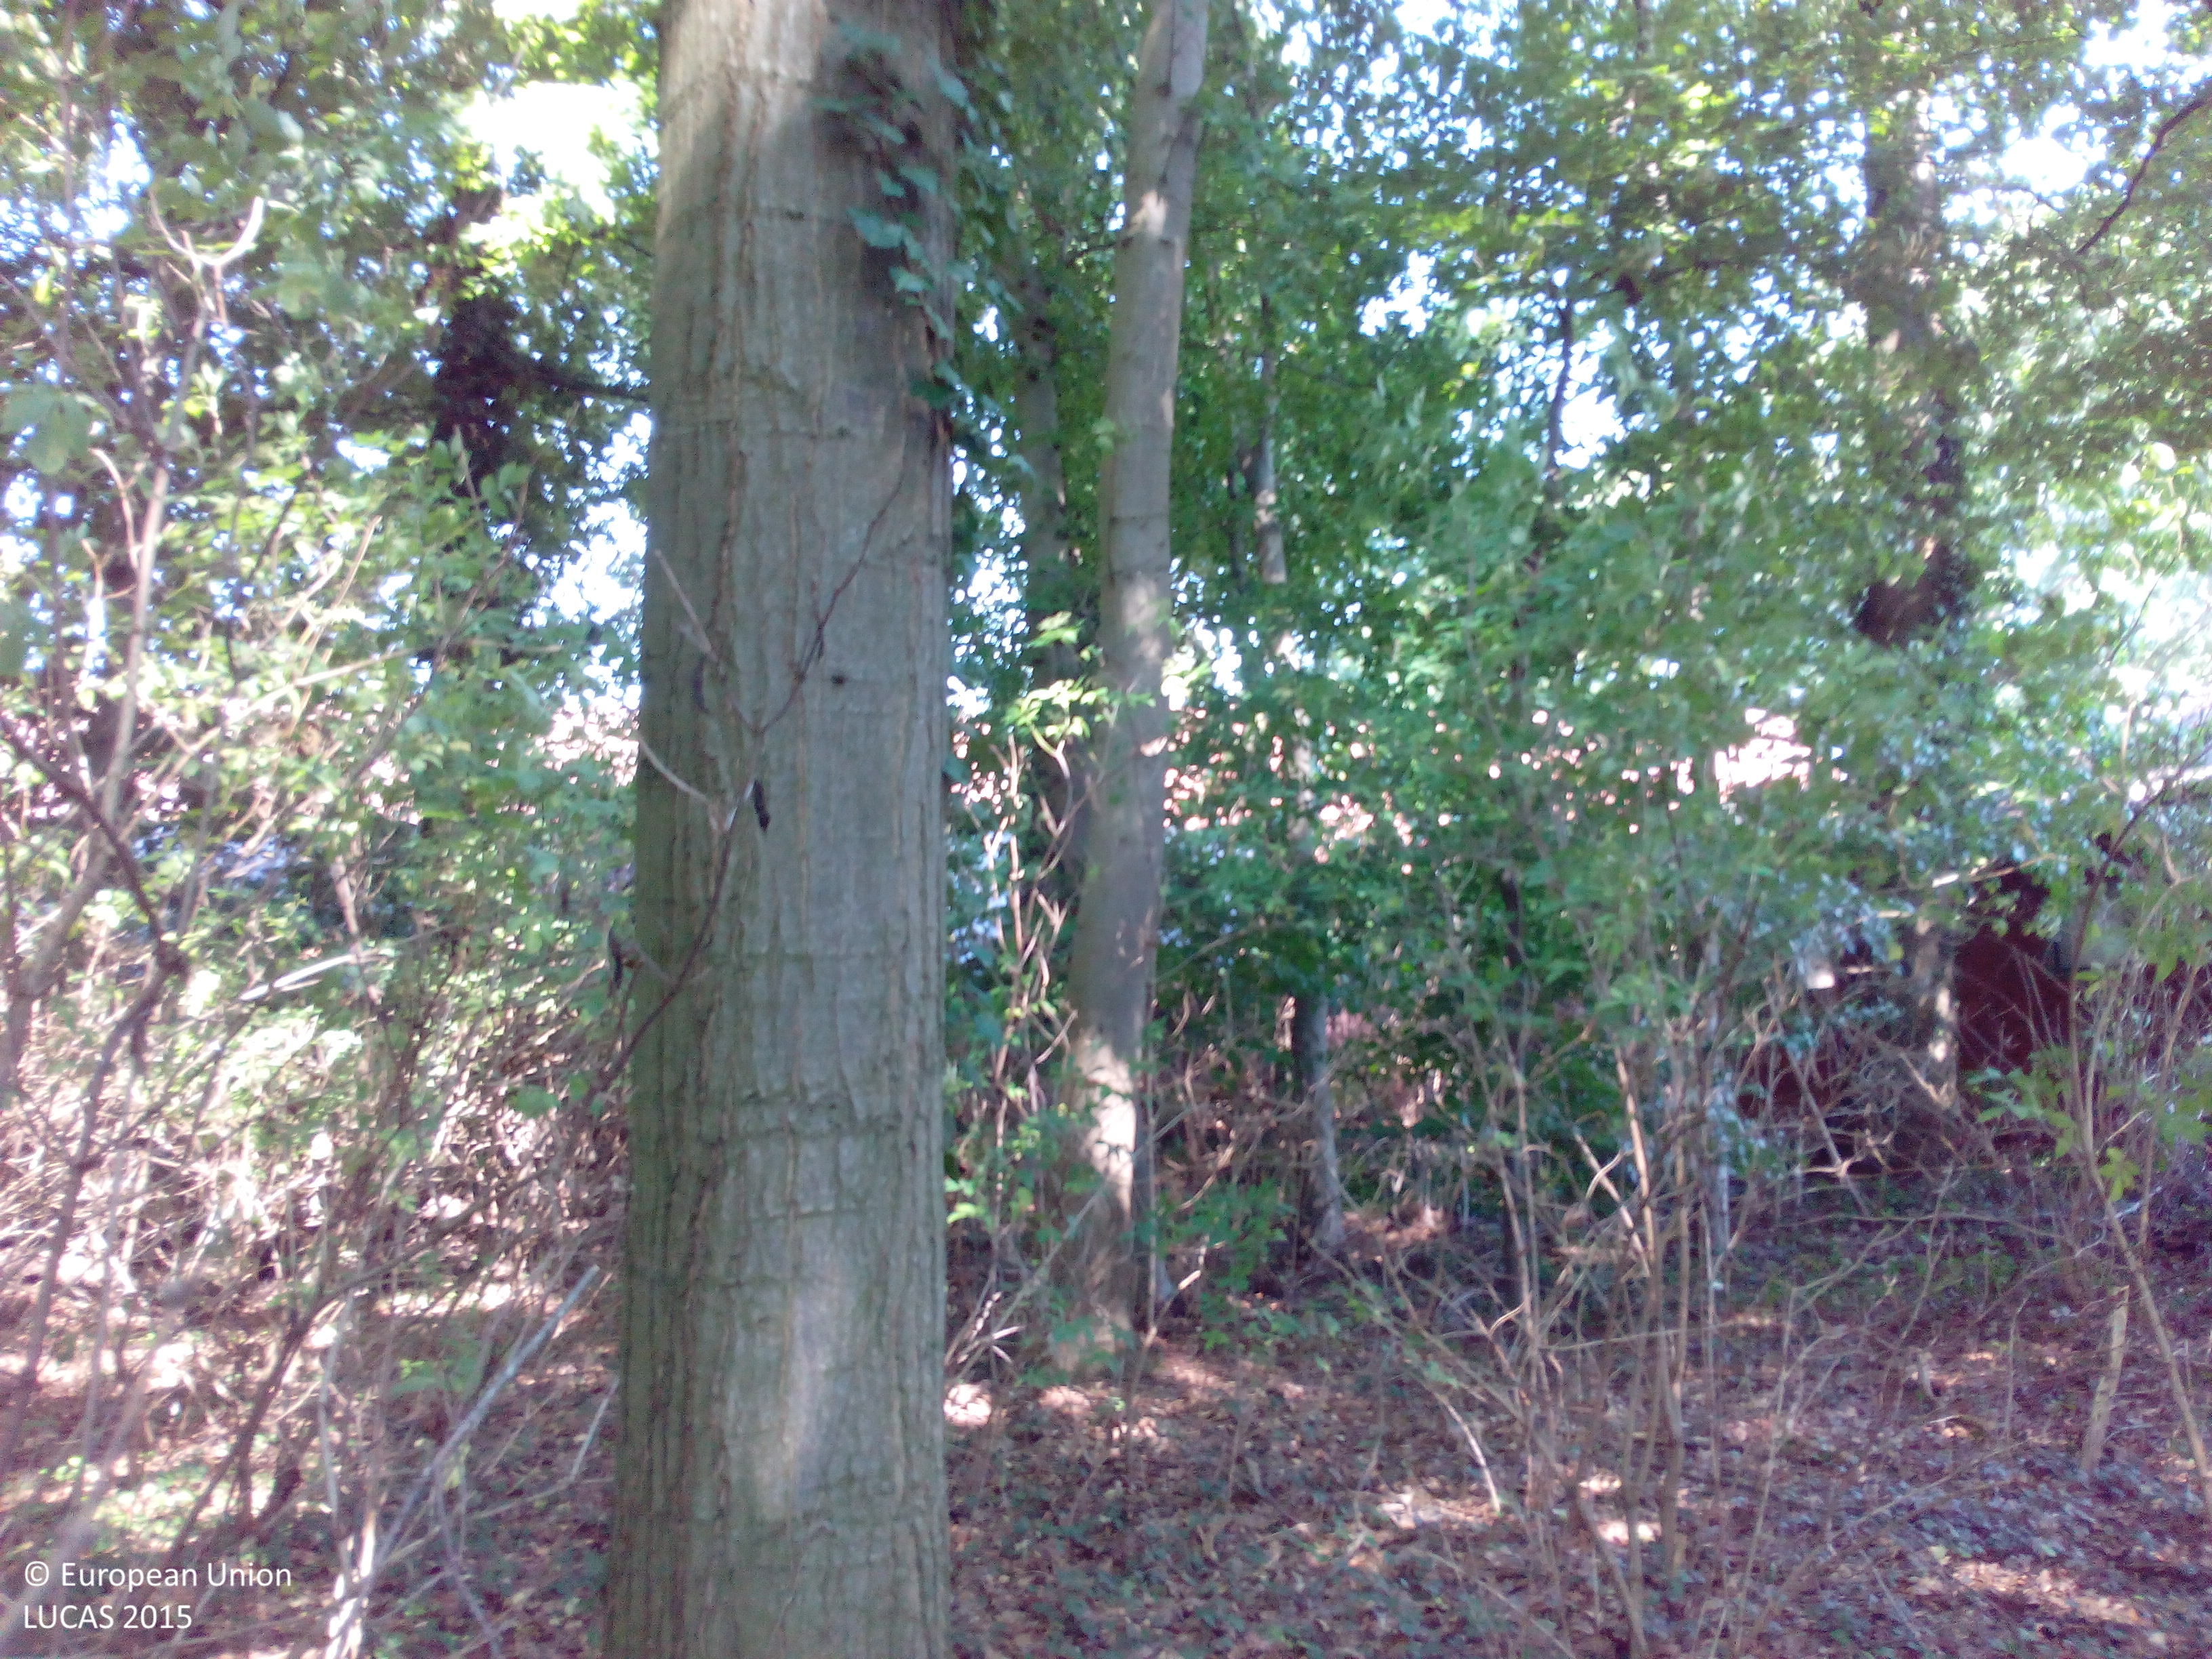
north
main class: Woodland
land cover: Broadleaved woodland
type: mesophytic deciduous forest
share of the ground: > 75 %
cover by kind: broadleaved forest trees 90 %, shrubs 5 %, herbaceous plants 5 %
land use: Forestry
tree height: > 5 m
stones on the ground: < 10 %
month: August
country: DE
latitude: 52.6474
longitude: 7.9460
